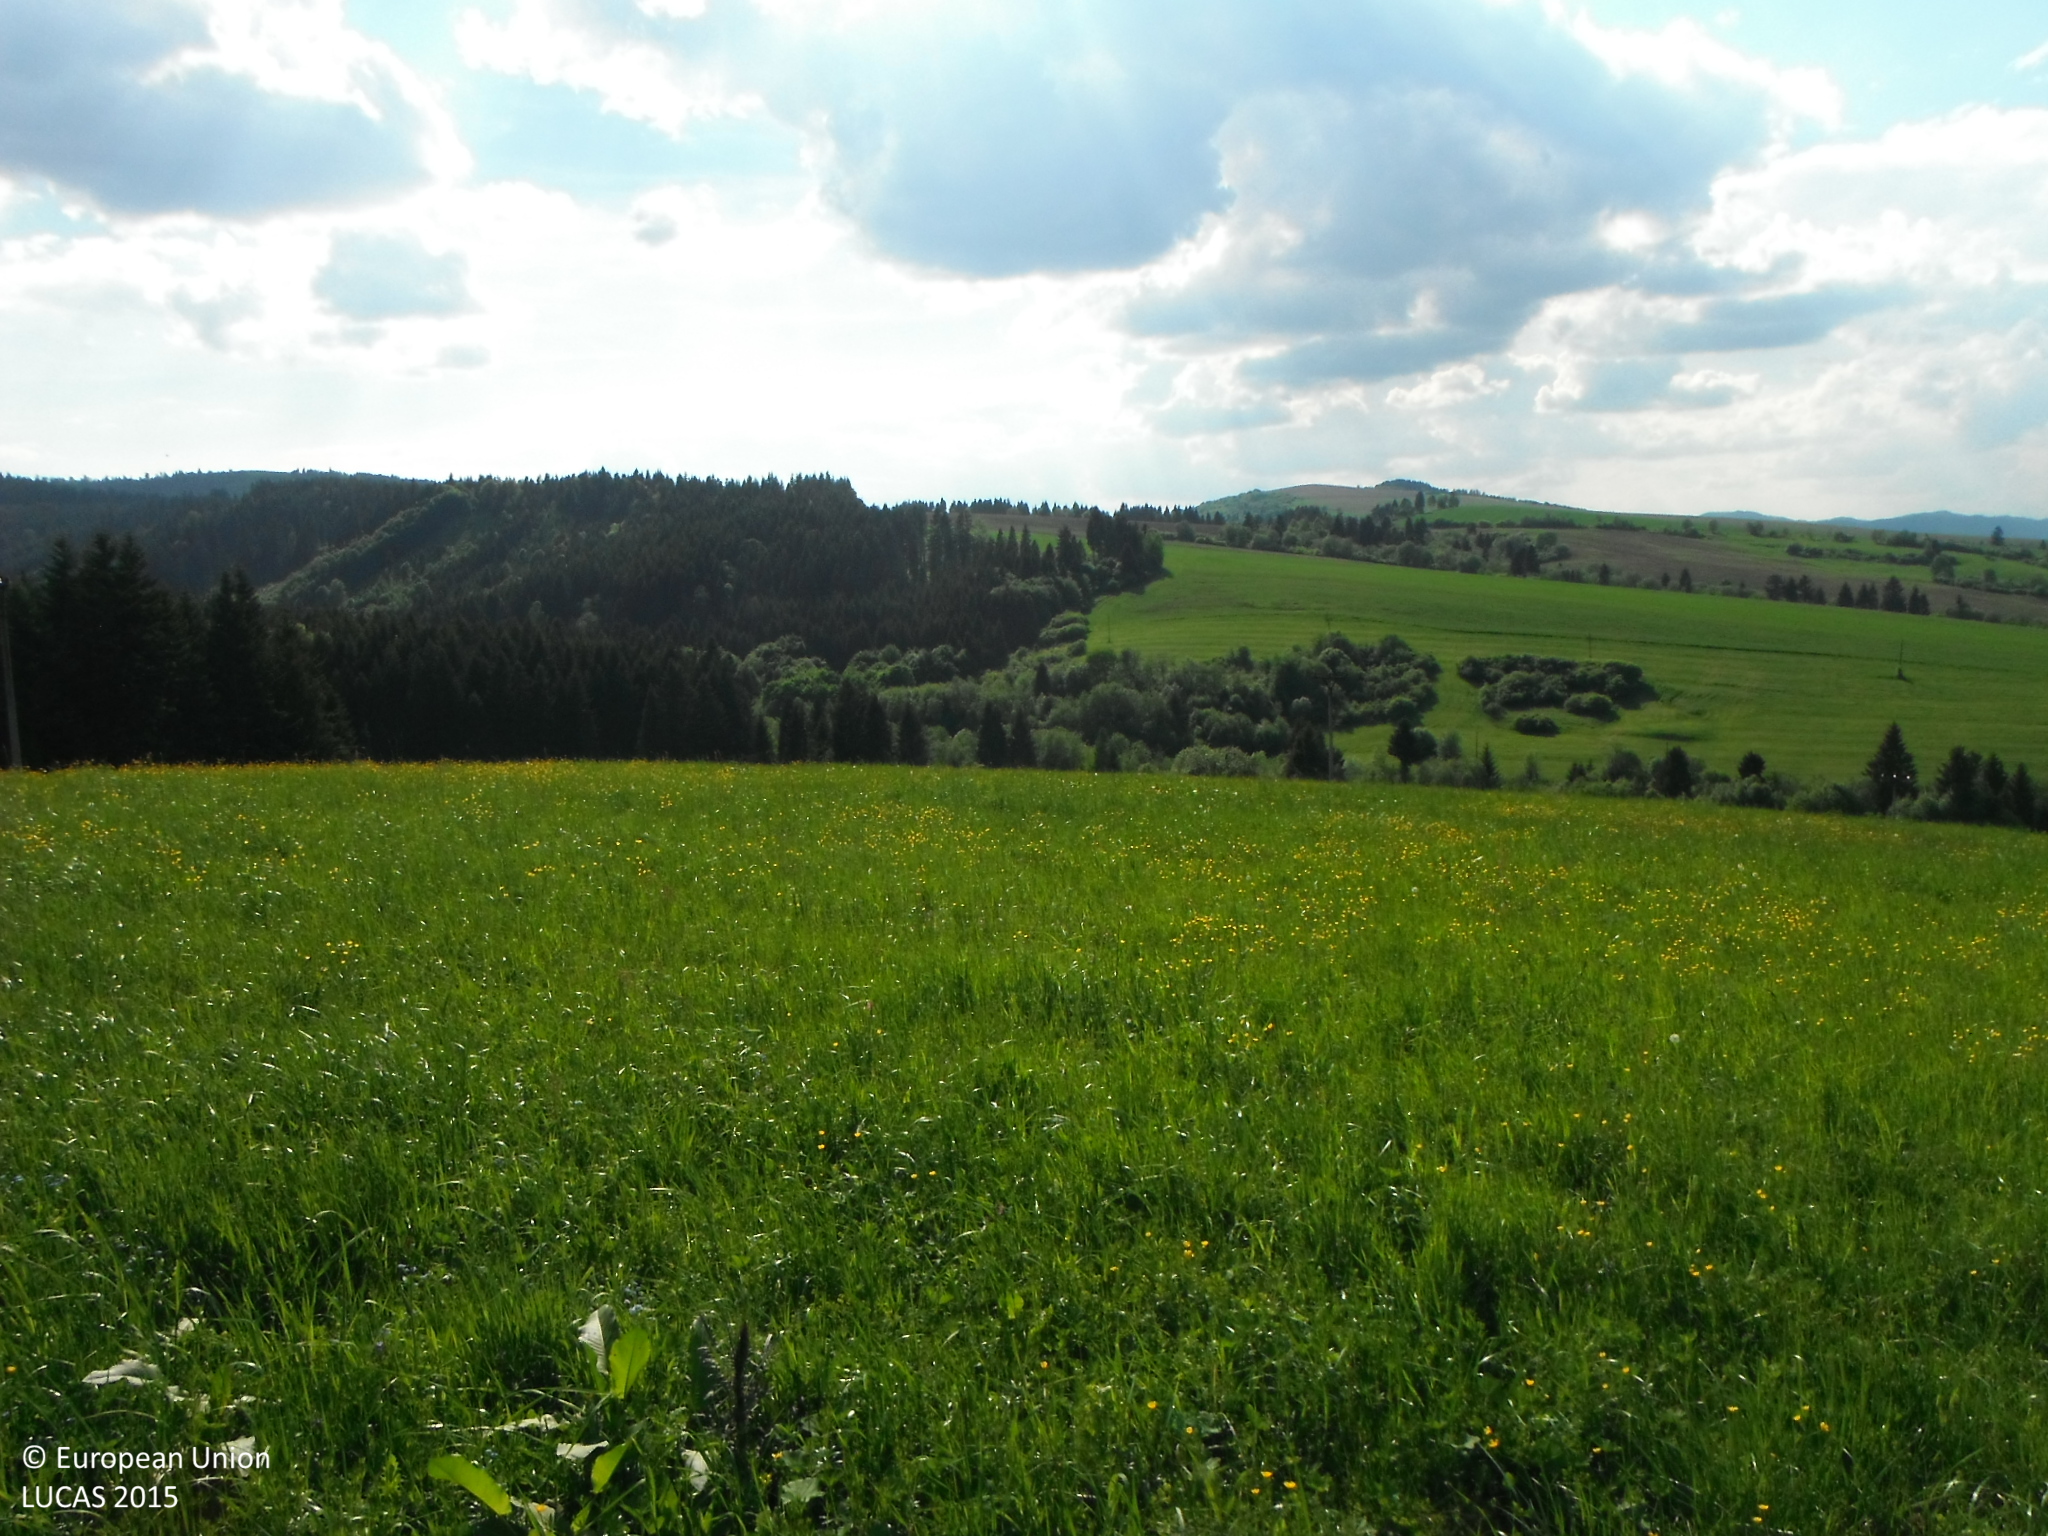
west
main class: Grassland
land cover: Grassland without tree/shrub cover
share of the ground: > 75 %
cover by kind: herbaceous plants 100 %
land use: Agriculture (excluding fallow land and kitchen gardens)
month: May
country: SK
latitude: 49.2755
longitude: 20.7468
